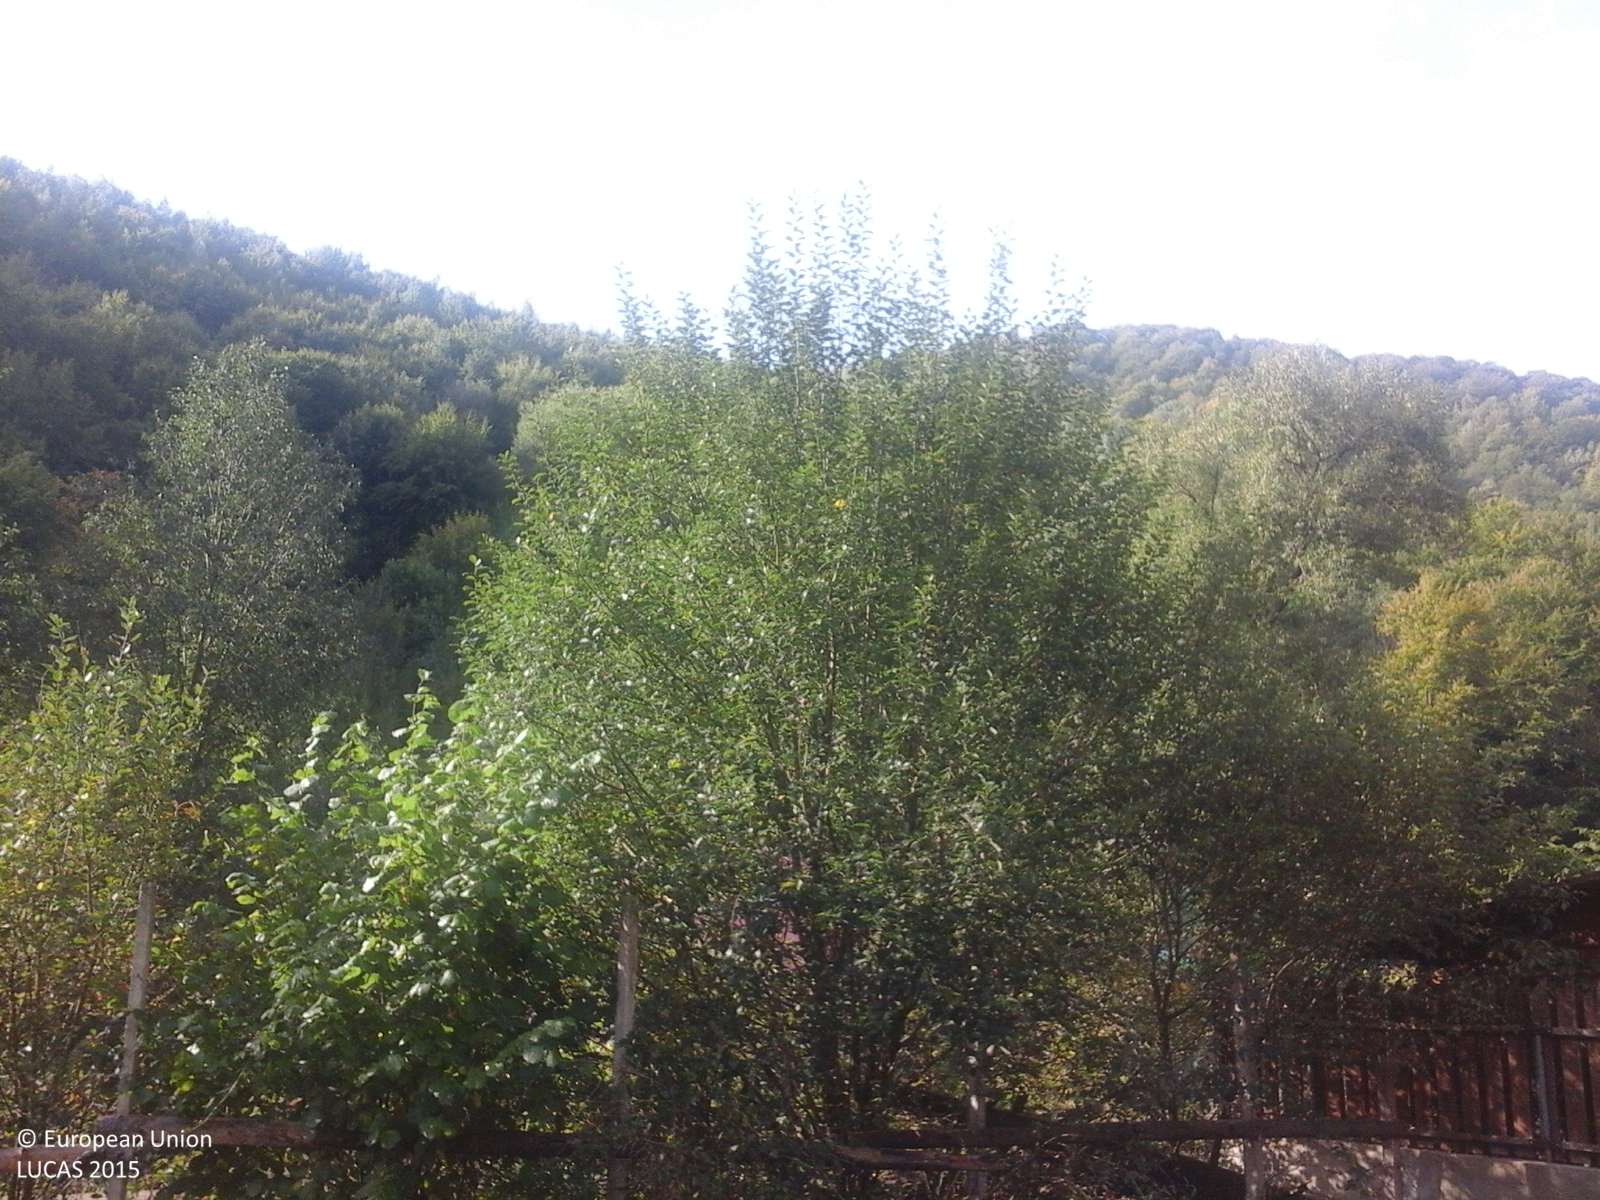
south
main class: Grassland
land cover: Grassland without tree/shrub cover
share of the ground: > 75 %
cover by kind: herbaceous plants 100 %
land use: Agriculture (excluding fallow land and kitchen gardens)
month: September
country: RO
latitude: 46.6858
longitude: 23.2838
